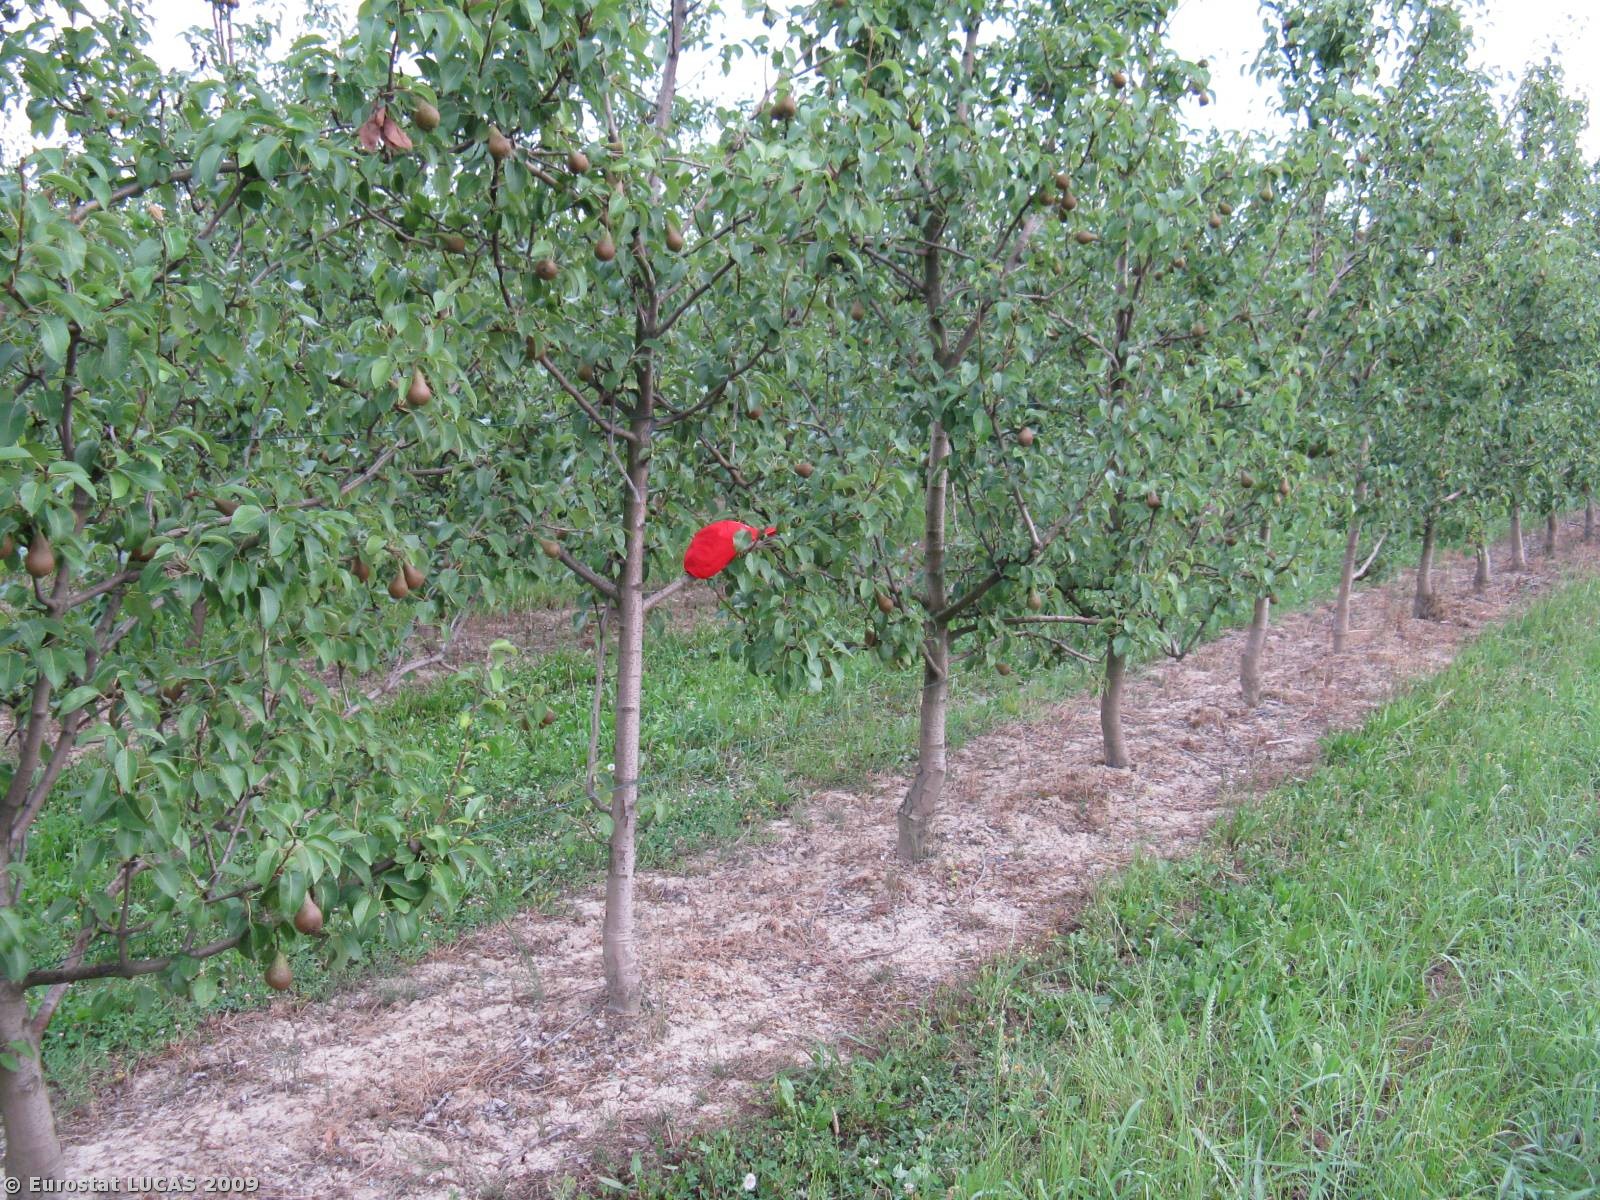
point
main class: Cropland
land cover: Pear fruit
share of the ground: 50 - 75 %
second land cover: Grassland with sparse tree/shrub cover
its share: 50 - 75 %
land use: Agriculture (excluding fallow land and kitchen gardens)
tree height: < 5 m
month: June
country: IT
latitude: 44.8051
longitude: 11.7287
